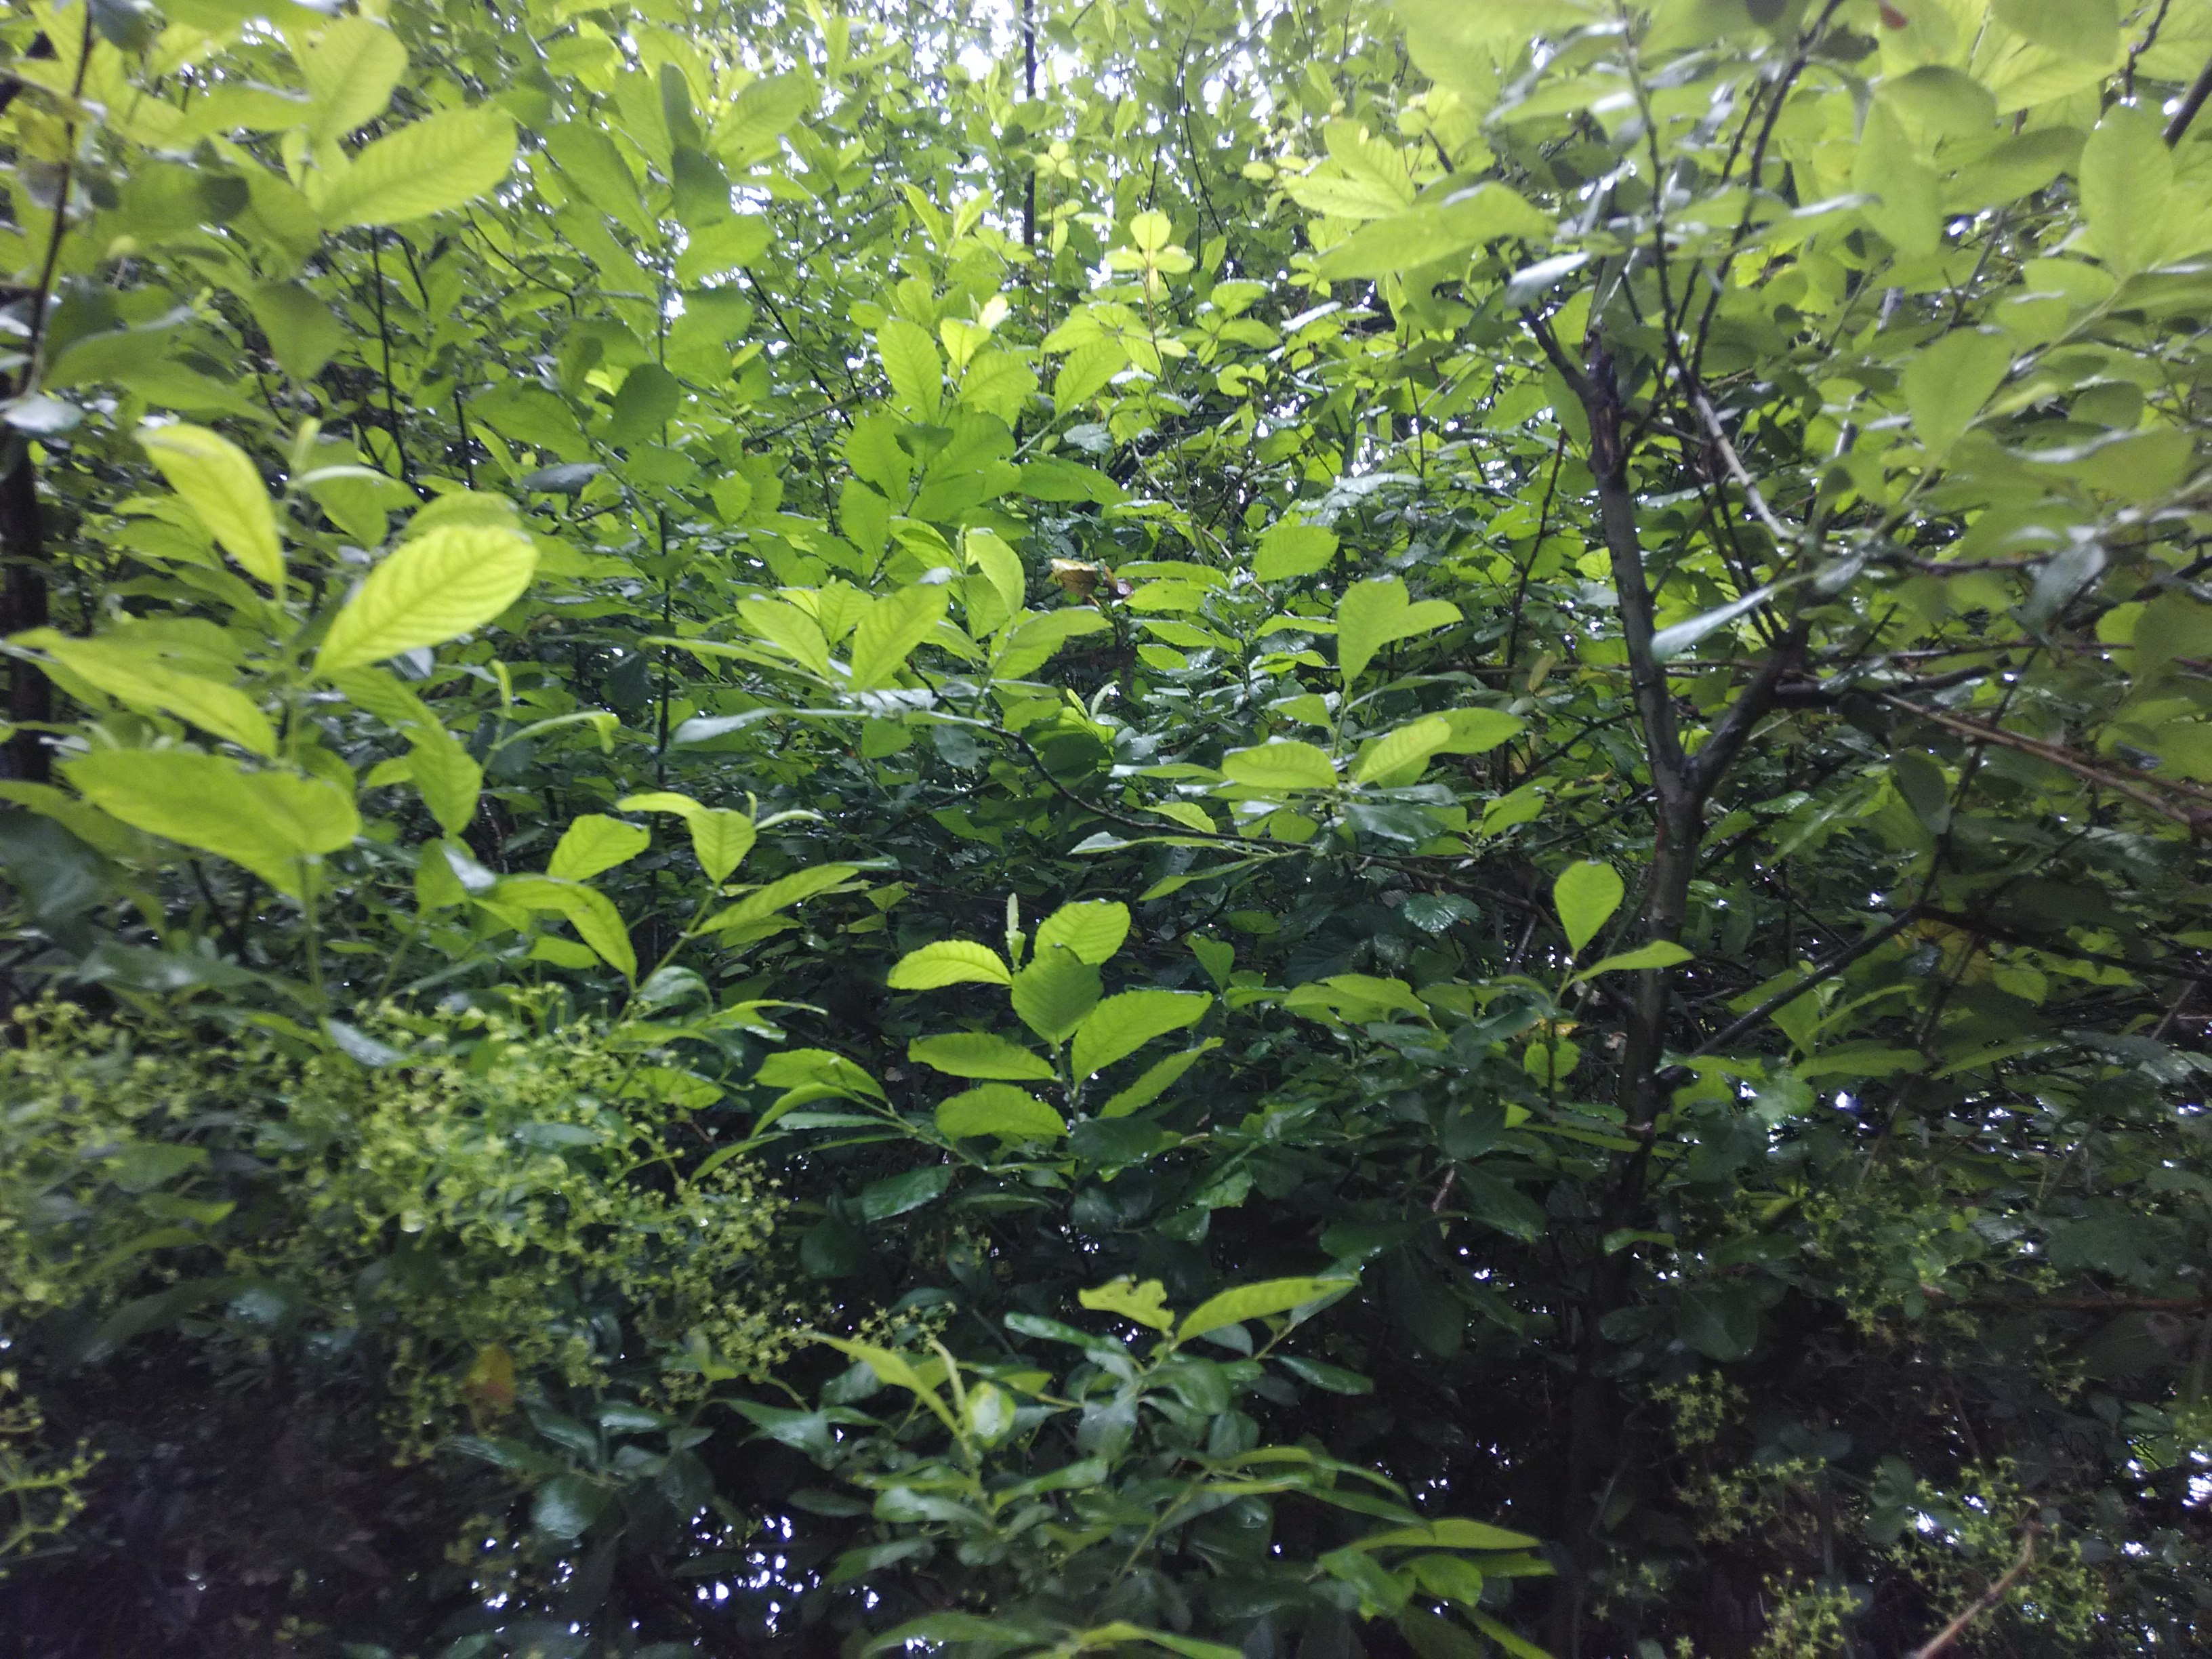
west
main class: Woodland
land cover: Broadleaved woodland
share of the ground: 25 - 50 %
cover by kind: shrubs 40 %, broadleaved forest trees 30 %, consolidated bare surface 30 %
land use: Semi-natural and natural areas not in use
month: June
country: ES
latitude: 43.2830
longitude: -2.3376
